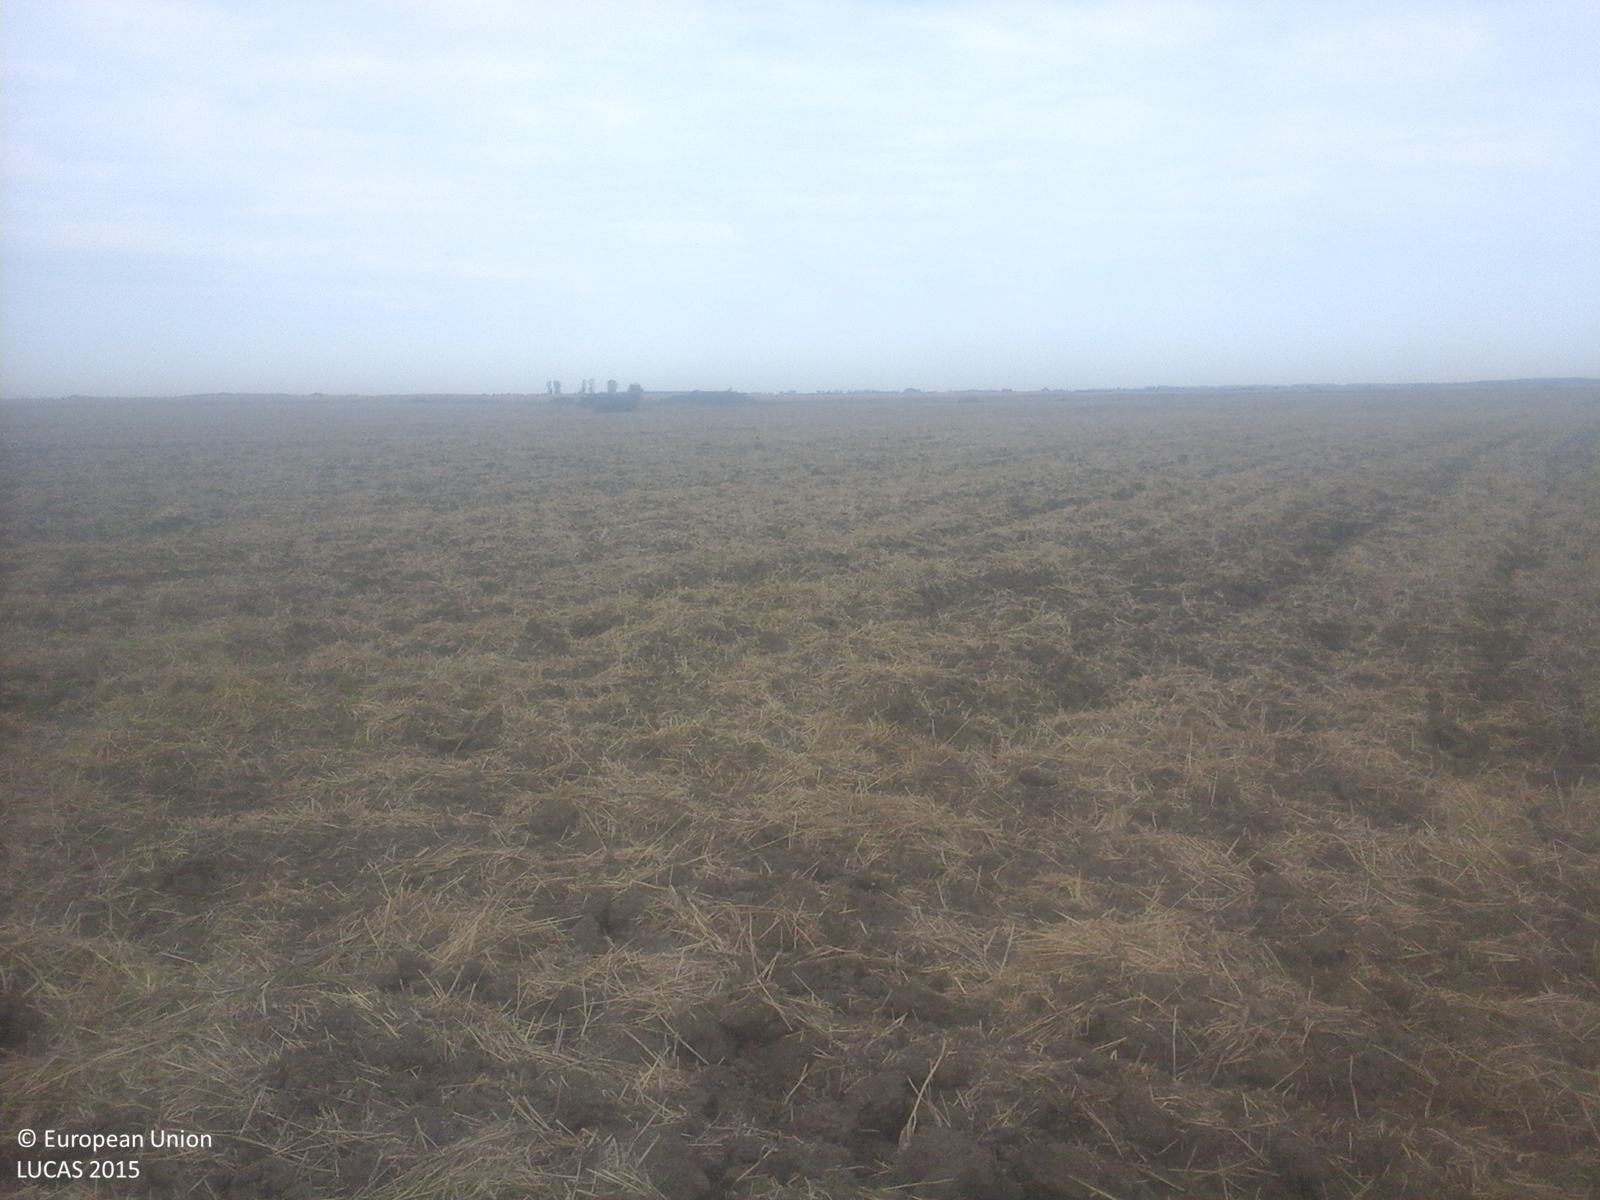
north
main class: Cropland
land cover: Common wheat
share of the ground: < 10 %
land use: Agriculture (excluding fallow land and kitchen gardens)
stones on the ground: < 10 %
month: September
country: RO
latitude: 47.7477
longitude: 22.6381
